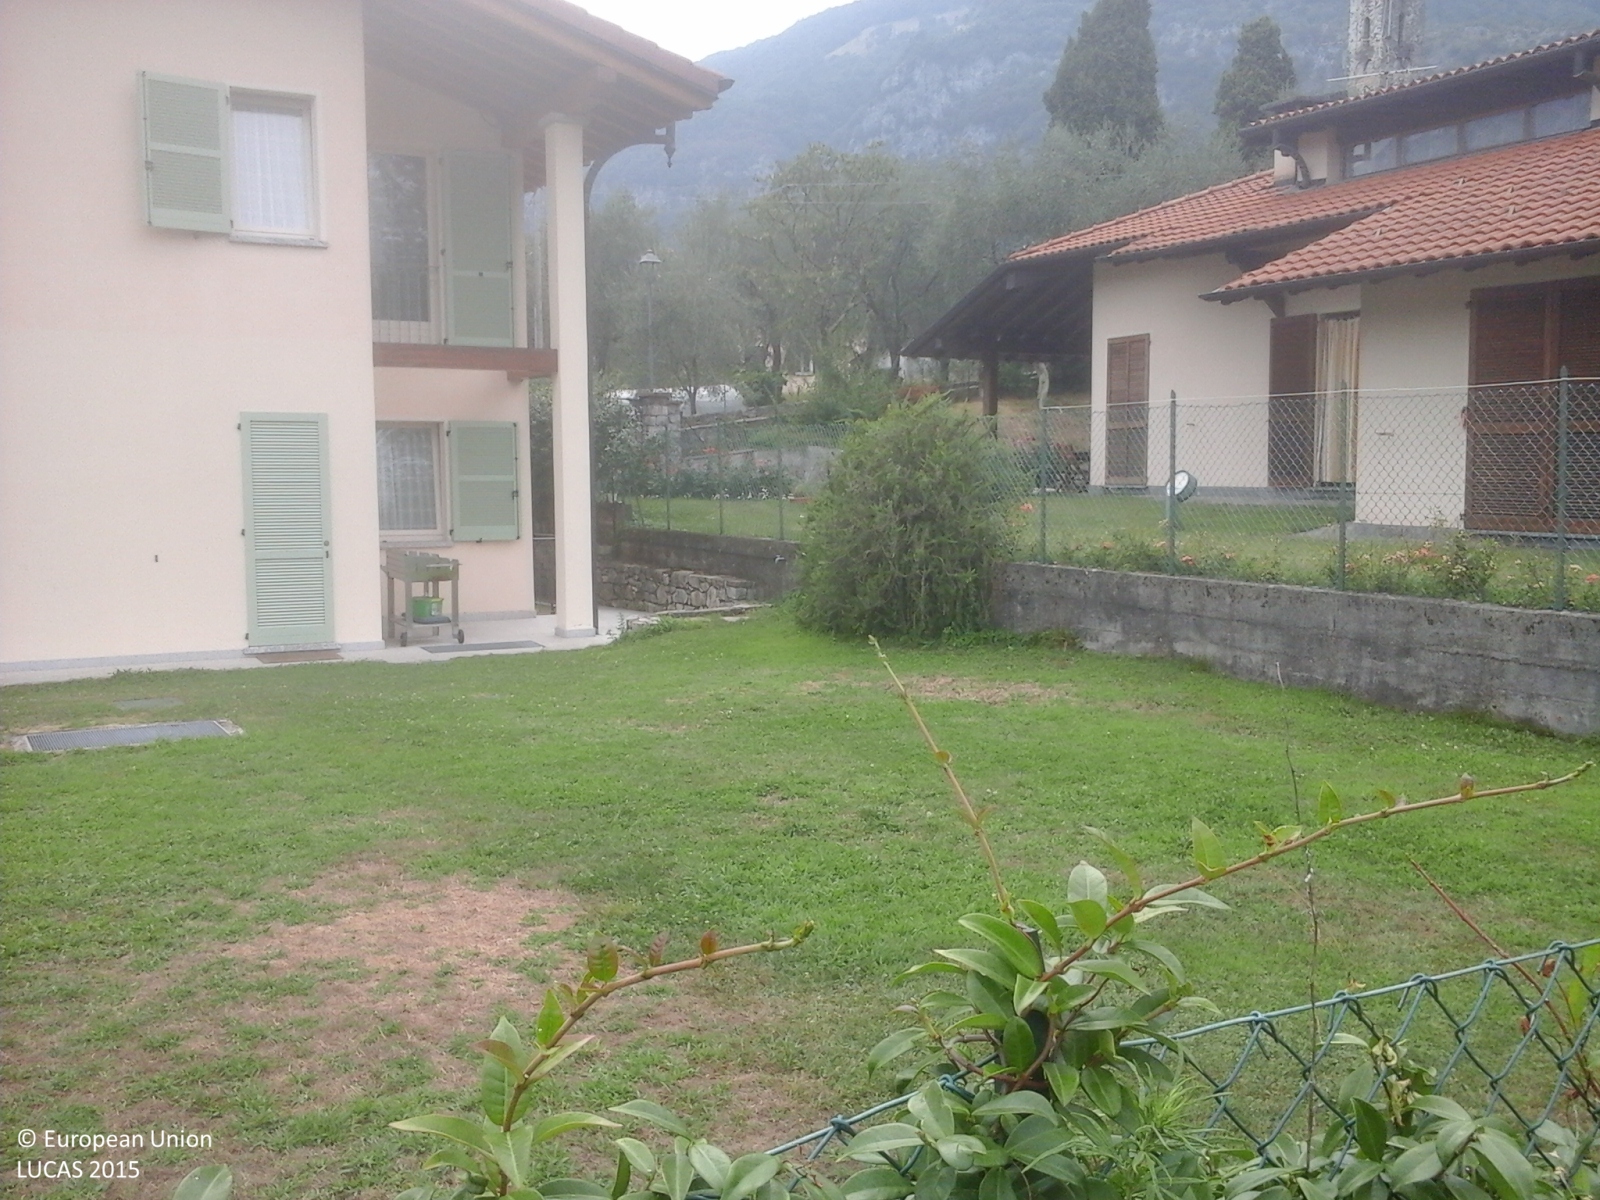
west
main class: Grassland
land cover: Grassland without tree/shrub cover
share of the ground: > 75 %
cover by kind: herbaceous plants 100 %
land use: Residential
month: August
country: IT
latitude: 45.9698
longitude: 9.1882
